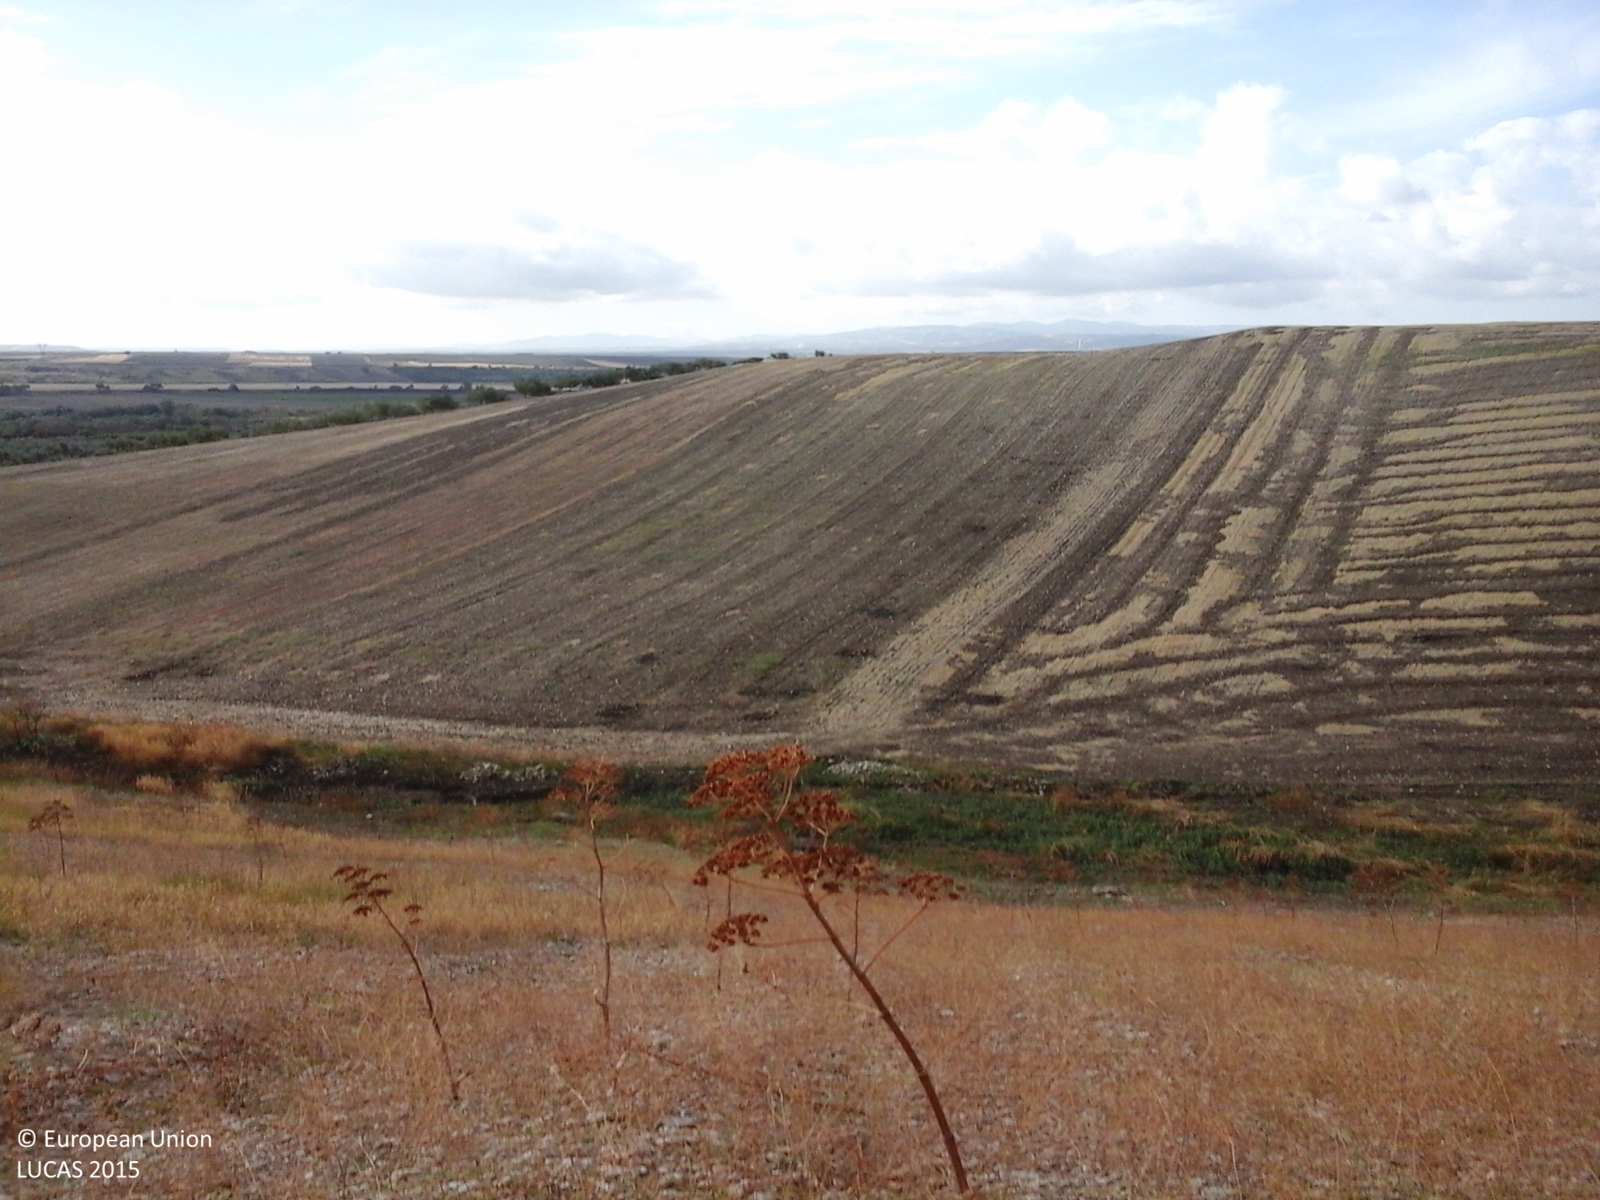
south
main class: Grassland
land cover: Grassland without tree/shrub cover
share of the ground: 50 - 75 %
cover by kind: herbaceous plants 60 %, consolidated bare surface 40 %
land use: Semi-natural and natural areas not in use
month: September
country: IT
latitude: 41.7259
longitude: 15.1647
